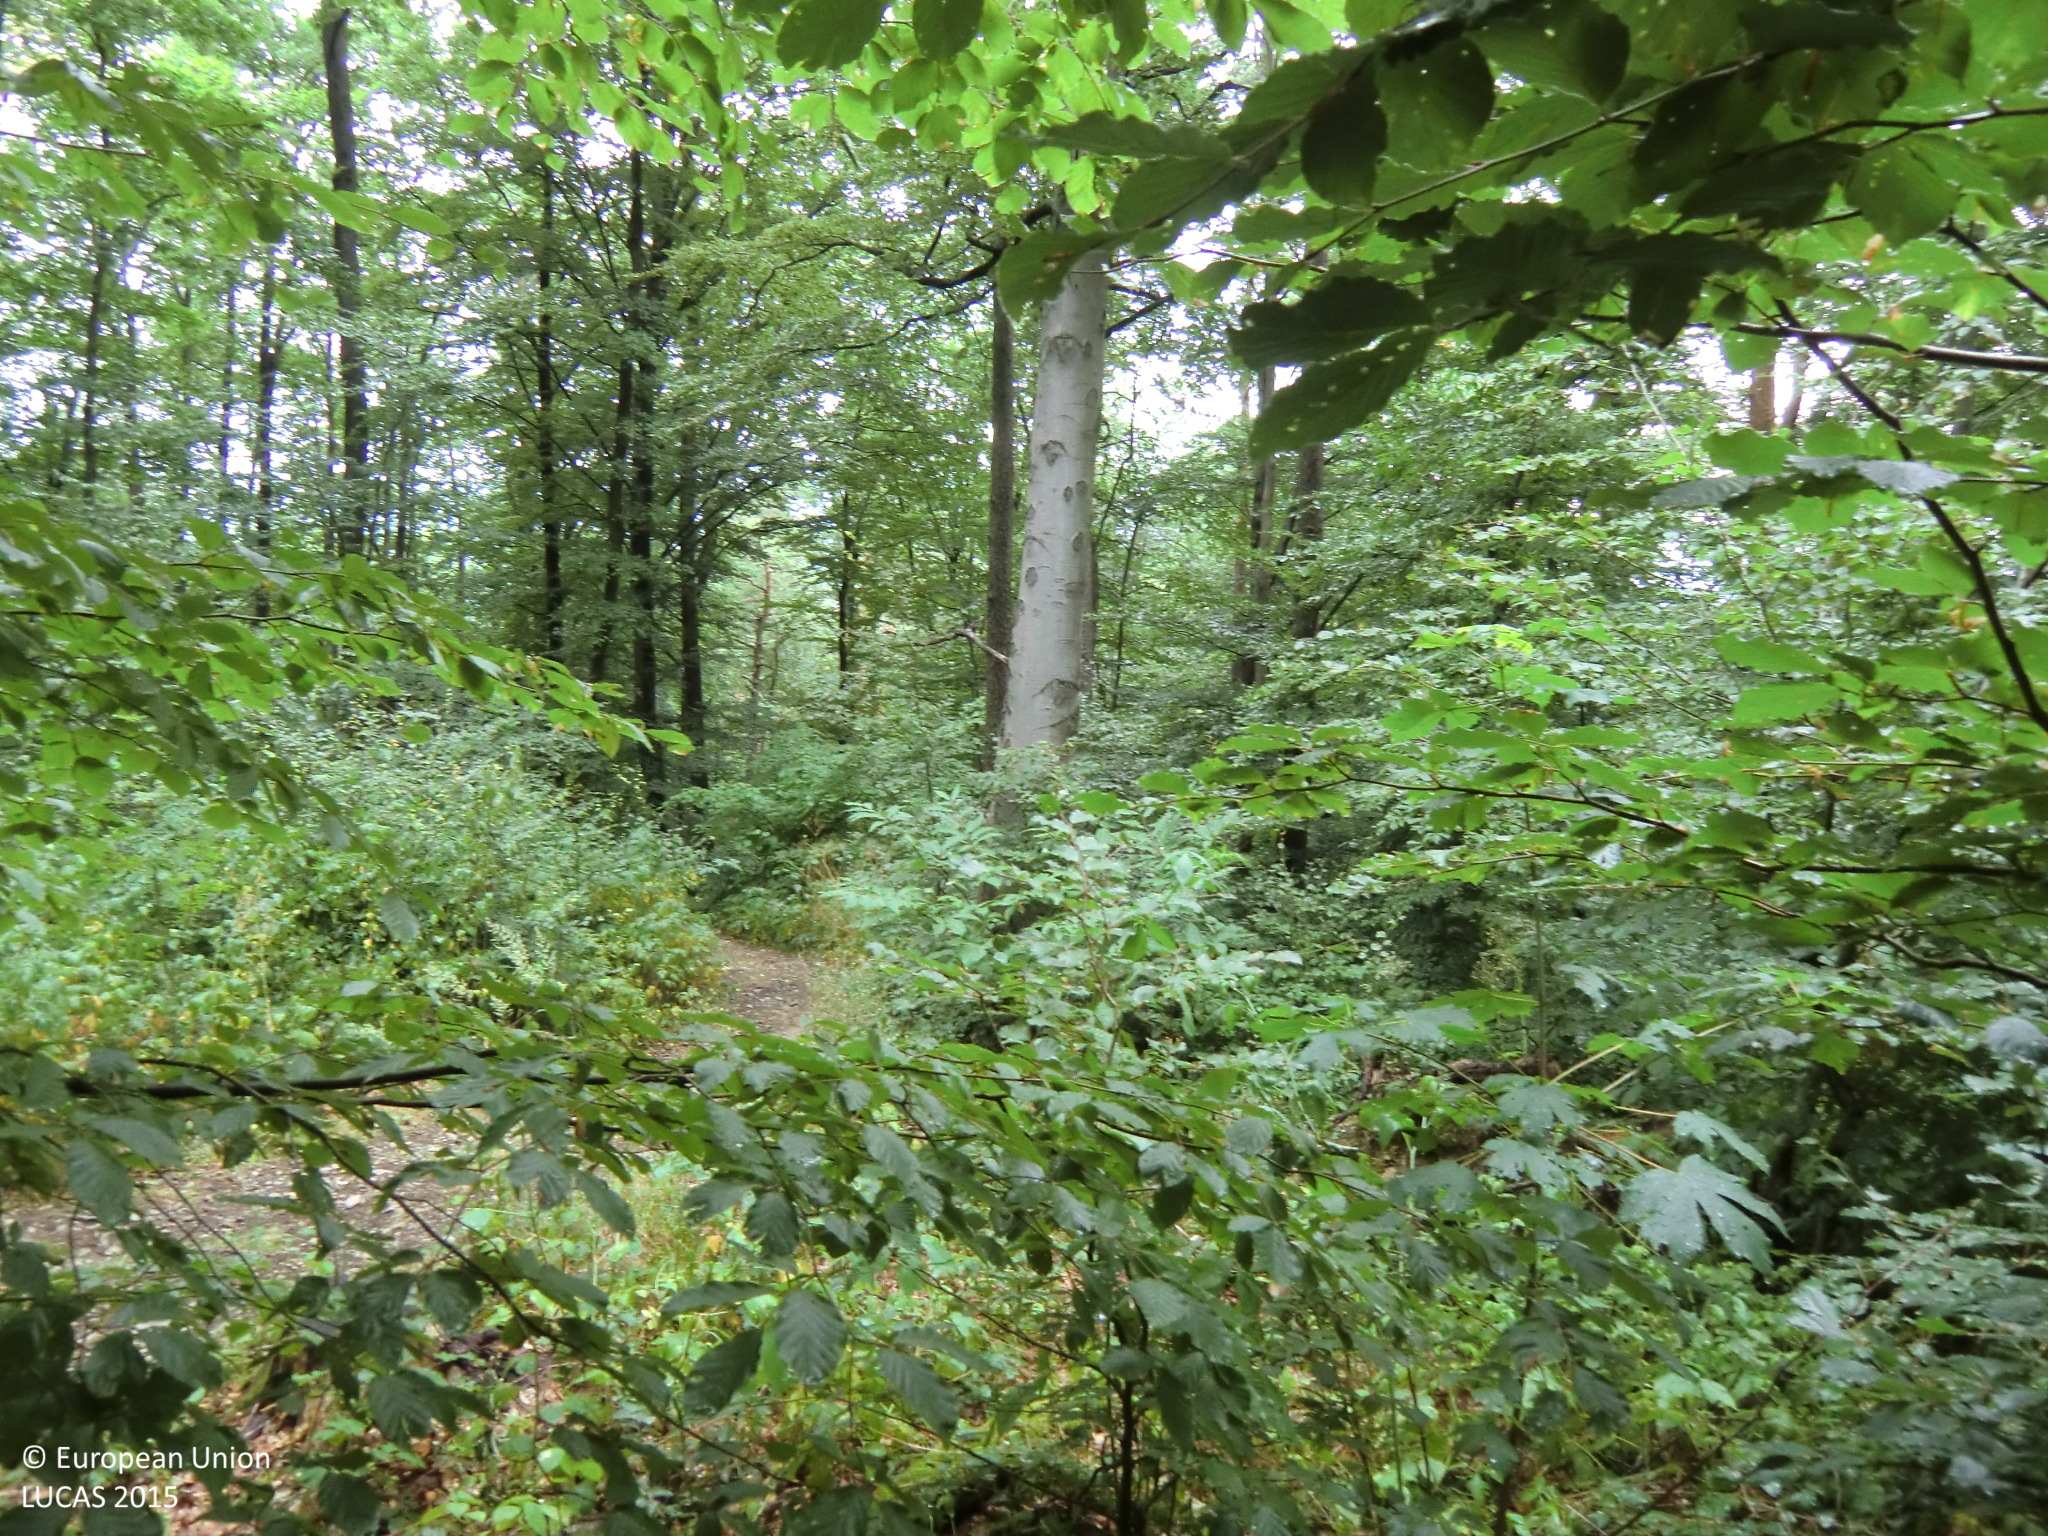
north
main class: Woodland
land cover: Pine dominated mixed woodland
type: hemiboreal forest and nemoral coniferous forest and mixed broadleaved-coniferous forest
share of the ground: 50 - 75 %
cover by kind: broadleaved forest trees 40 %, coniferous forest trees 30 %, shrubs 20 %, unconsolidated bare surface 10 %
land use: Forestry
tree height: > 5 m
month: July
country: AT
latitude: 47.1137
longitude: 15.4693
